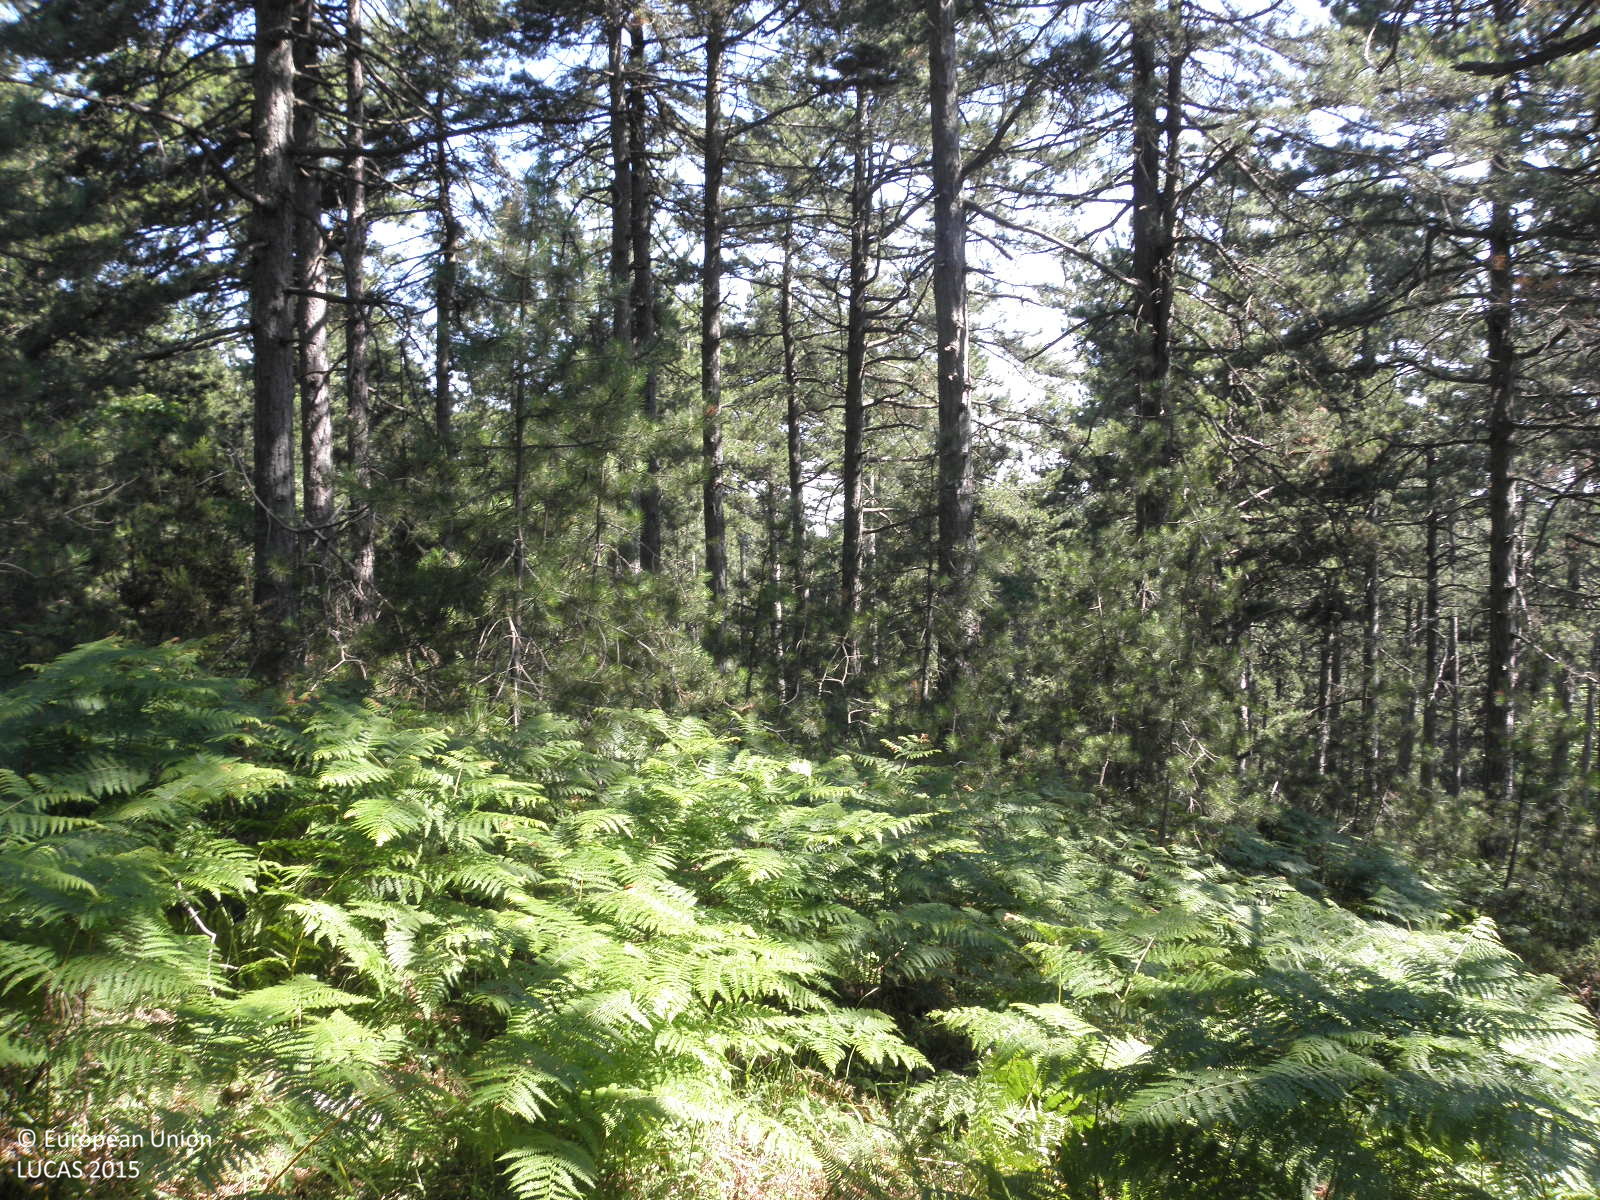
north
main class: Woodland
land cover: Pine dominated coniferous woodland
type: coniferous forest of the mediterranean region
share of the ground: > 75 %
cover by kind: coniferous forest trees 90 %, herbaceous plants 10 %
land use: Forestry
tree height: > 5 m
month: July
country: GR
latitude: 39.9660
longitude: 22.5809
